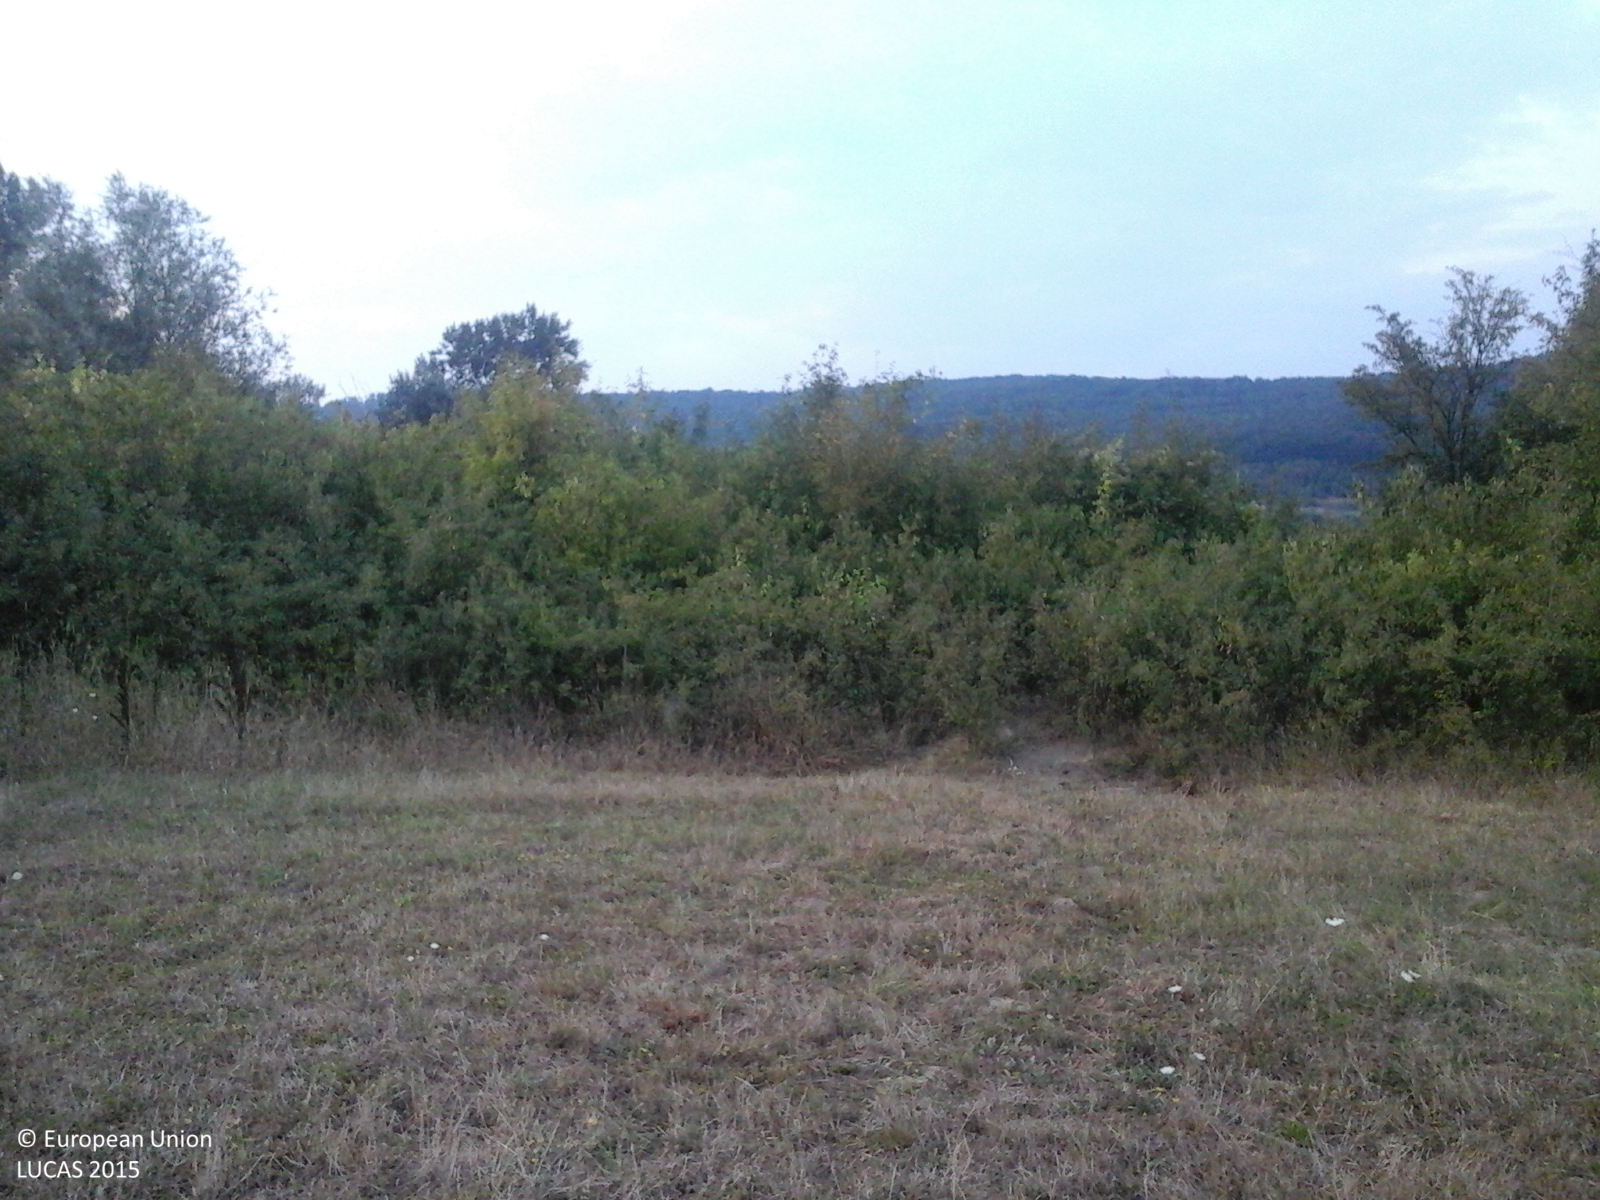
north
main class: Grassland
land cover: Grassland without tree/shrub cover
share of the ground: > 75 %
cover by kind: herbaceous plants 100 %
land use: Agriculture (excluding fallow land and kitchen gardens)
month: August
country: RO
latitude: 44.6801
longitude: 23.1316
